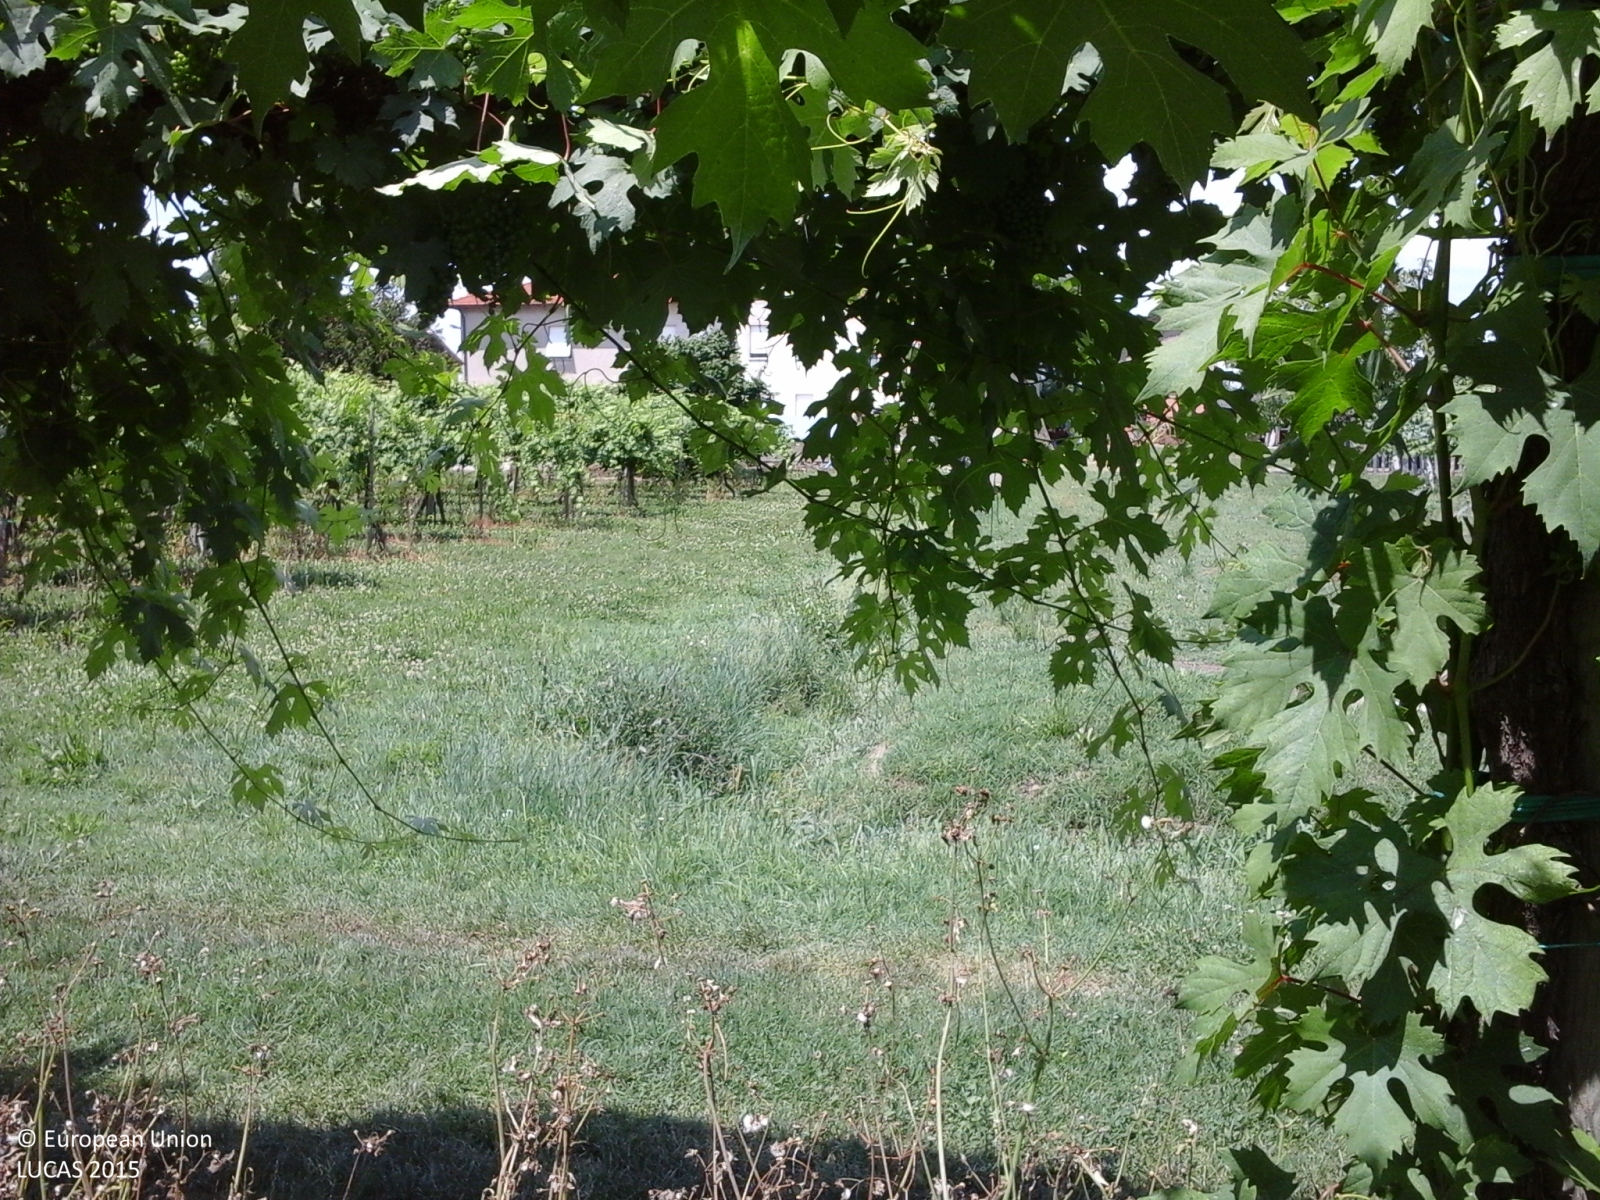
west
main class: Cropland
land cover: Vineyards
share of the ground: 50 - 75 %
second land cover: Grassland without tree/shrub cover
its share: > 75 %
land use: Agriculture (excluding fallow land and kitchen gardens)
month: June
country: IT
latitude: 44.6907
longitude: 10.7177
